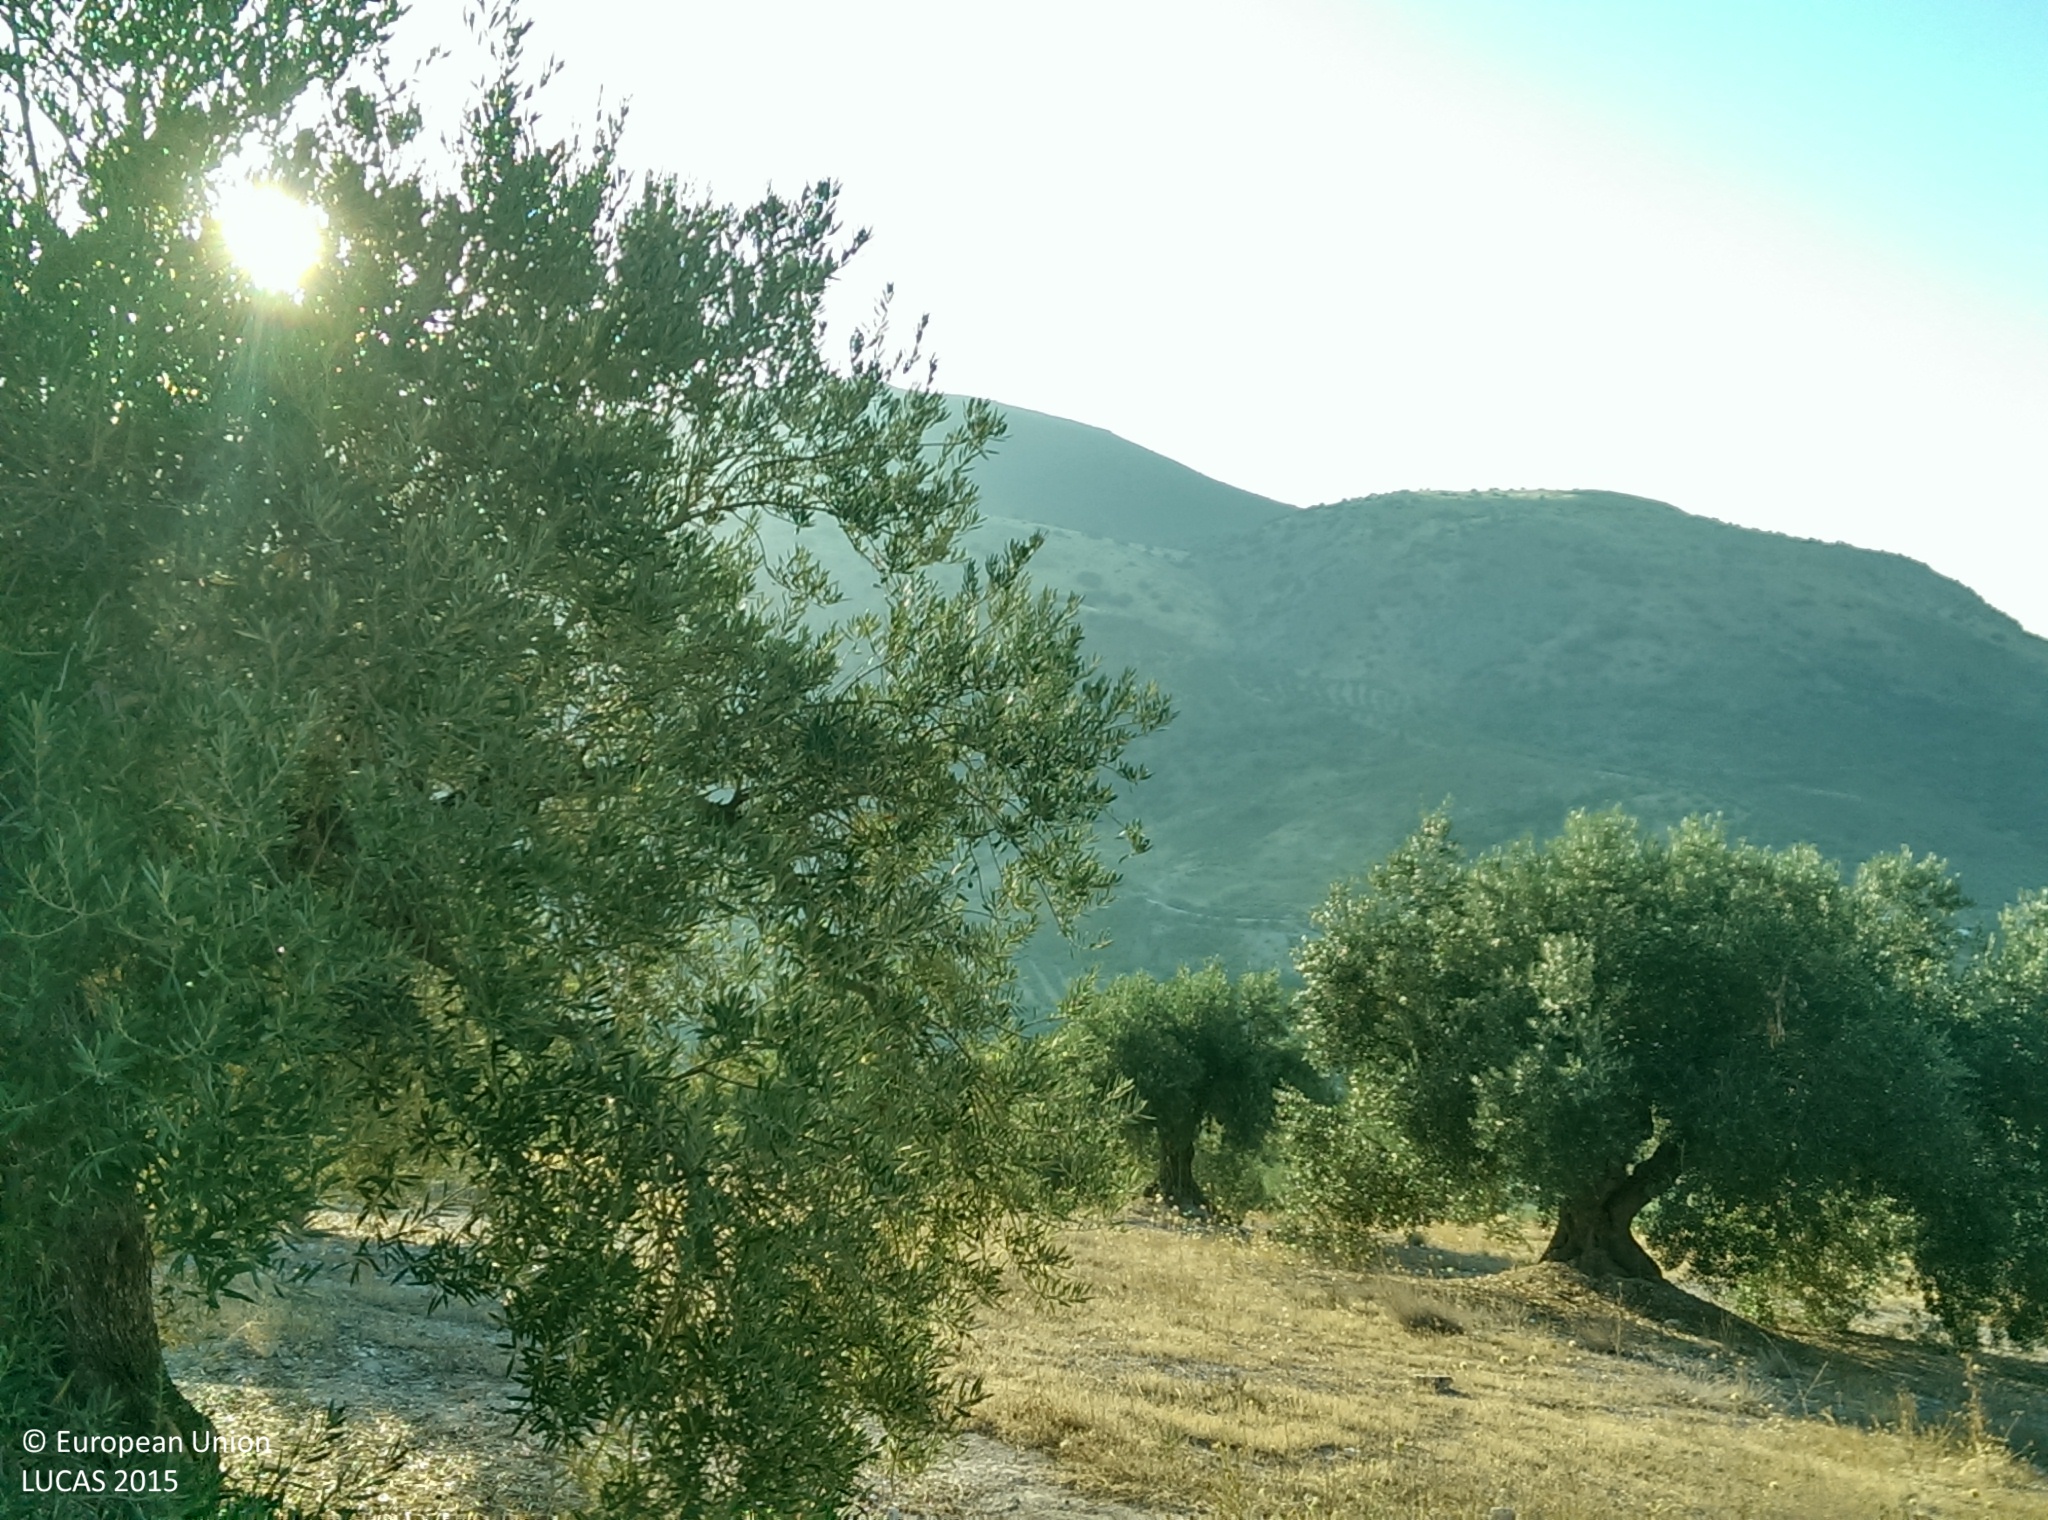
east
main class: Cropland
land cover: Olive groves
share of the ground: 25 - 50 %
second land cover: Spontaneously vegetated surfaces
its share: 10 - 25 %
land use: Agriculture (excluding fallow land and kitchen gardens)
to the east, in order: Olive groves; Spontaneously vegetated surfaces; Grassland without tree/shrub cover; Other structural elements; Paved roads, cycling and walking lanes; Dry stone walls; Olive groves
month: July
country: ES
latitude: 37.3554
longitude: -3.7103
